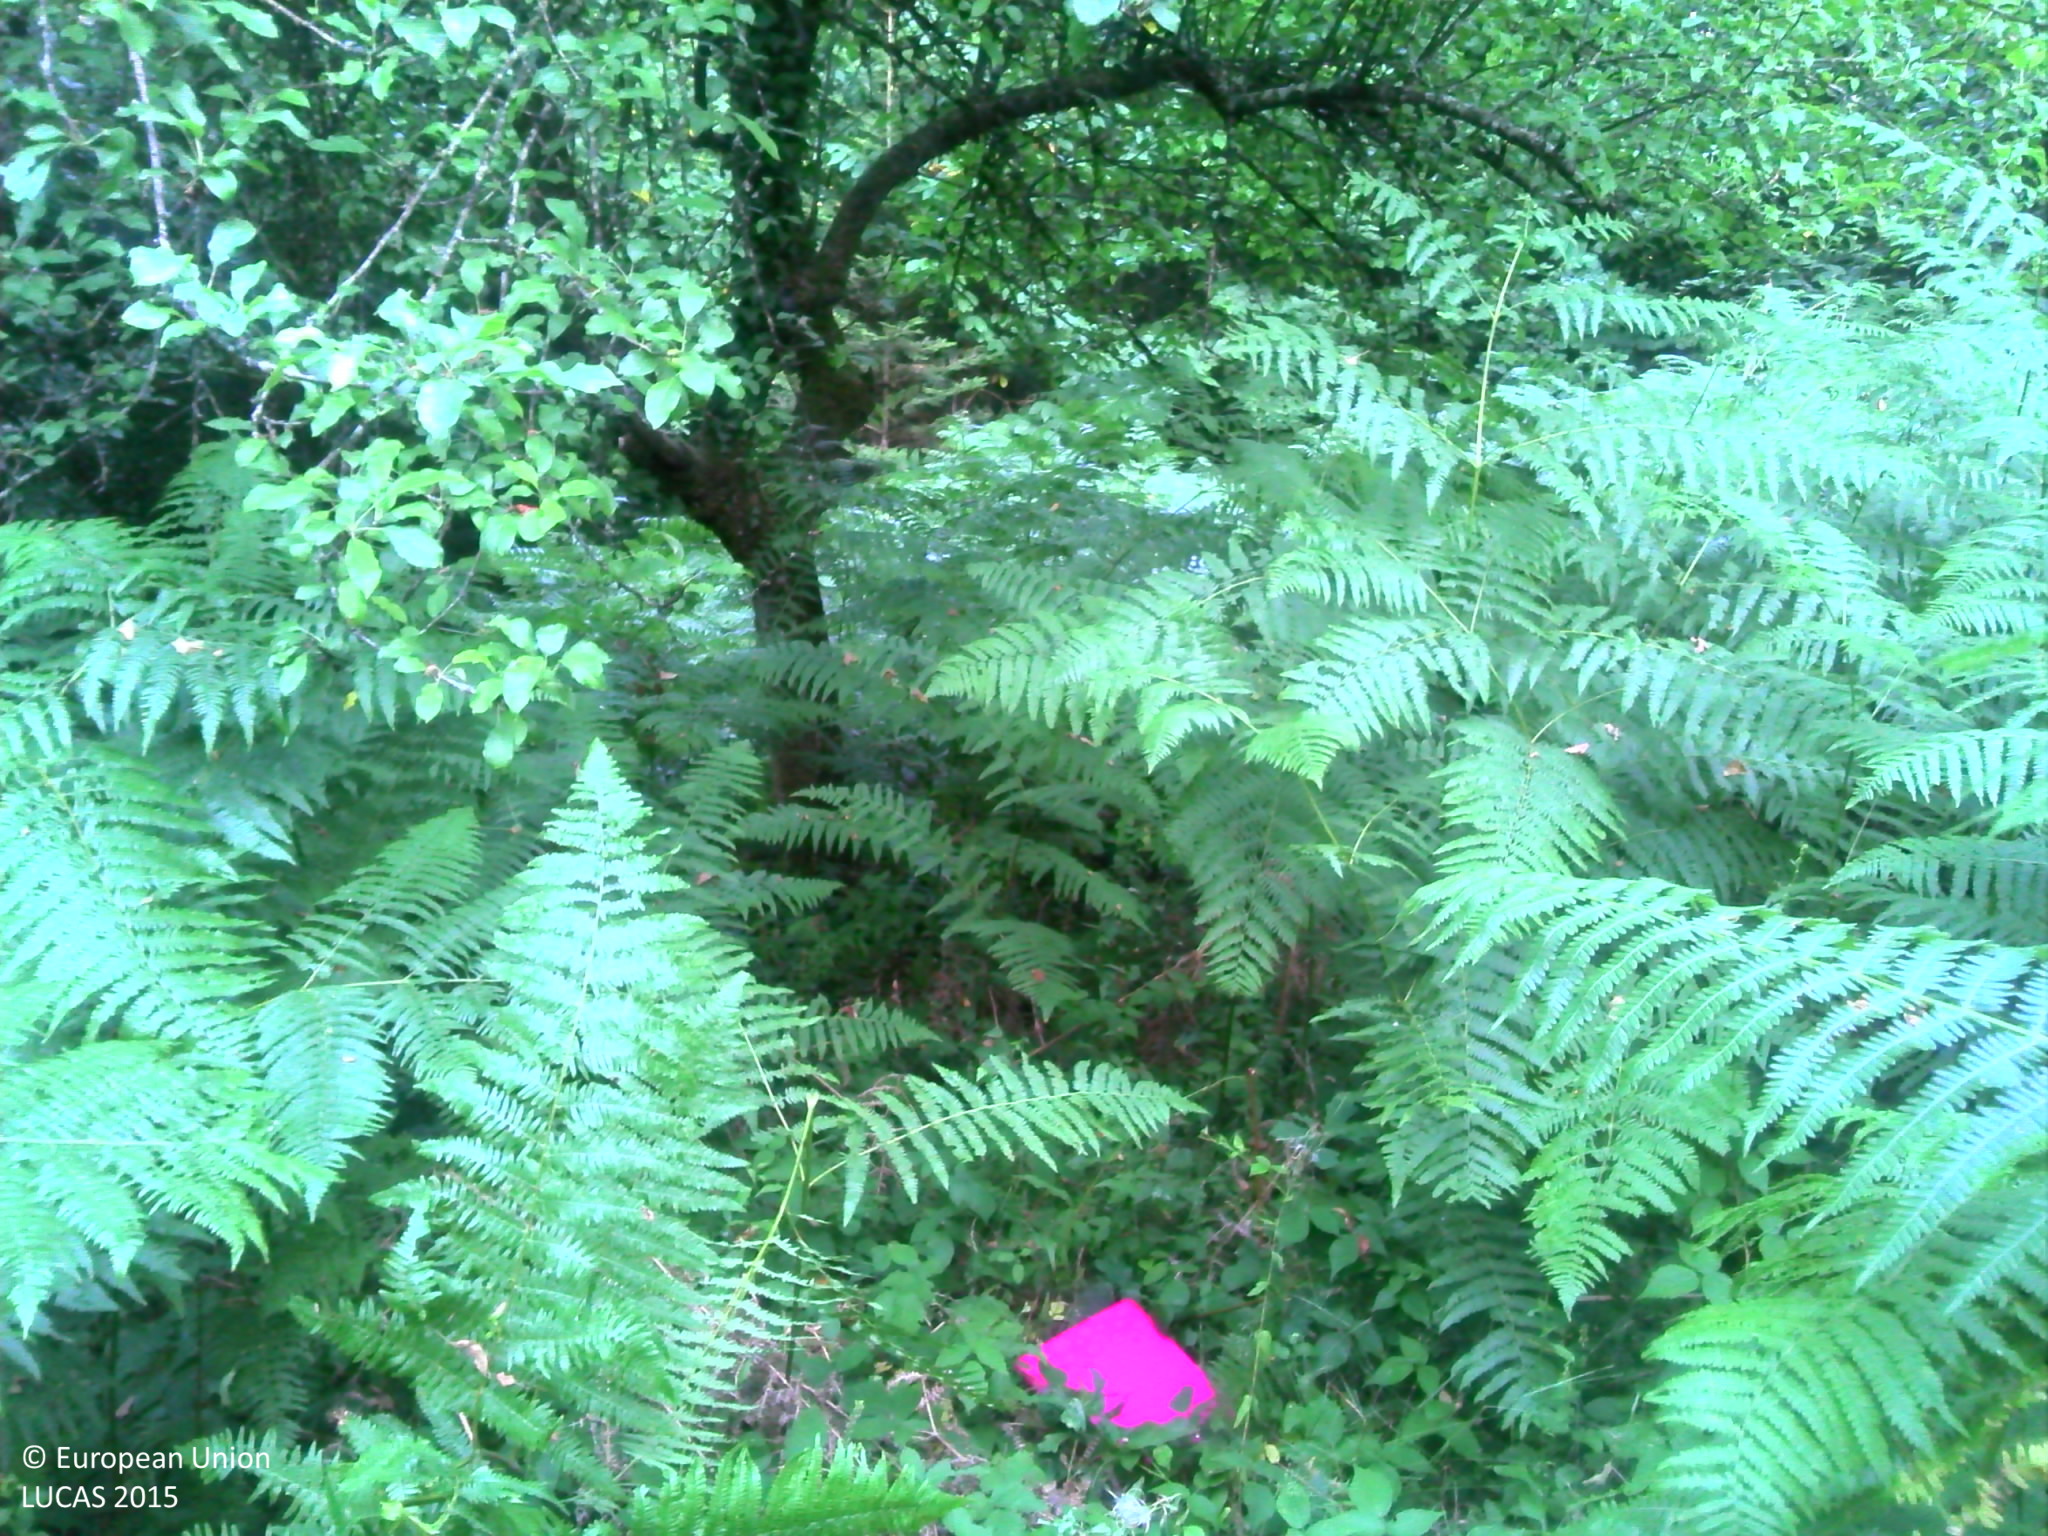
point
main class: Cropland
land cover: Apple fruit
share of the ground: 25 - 50 %
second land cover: Spontaneously vegetated surfaces
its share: 50 - 75 %
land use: Abandoned areas
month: July
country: FR
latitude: 45.9475
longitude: 1.5943
